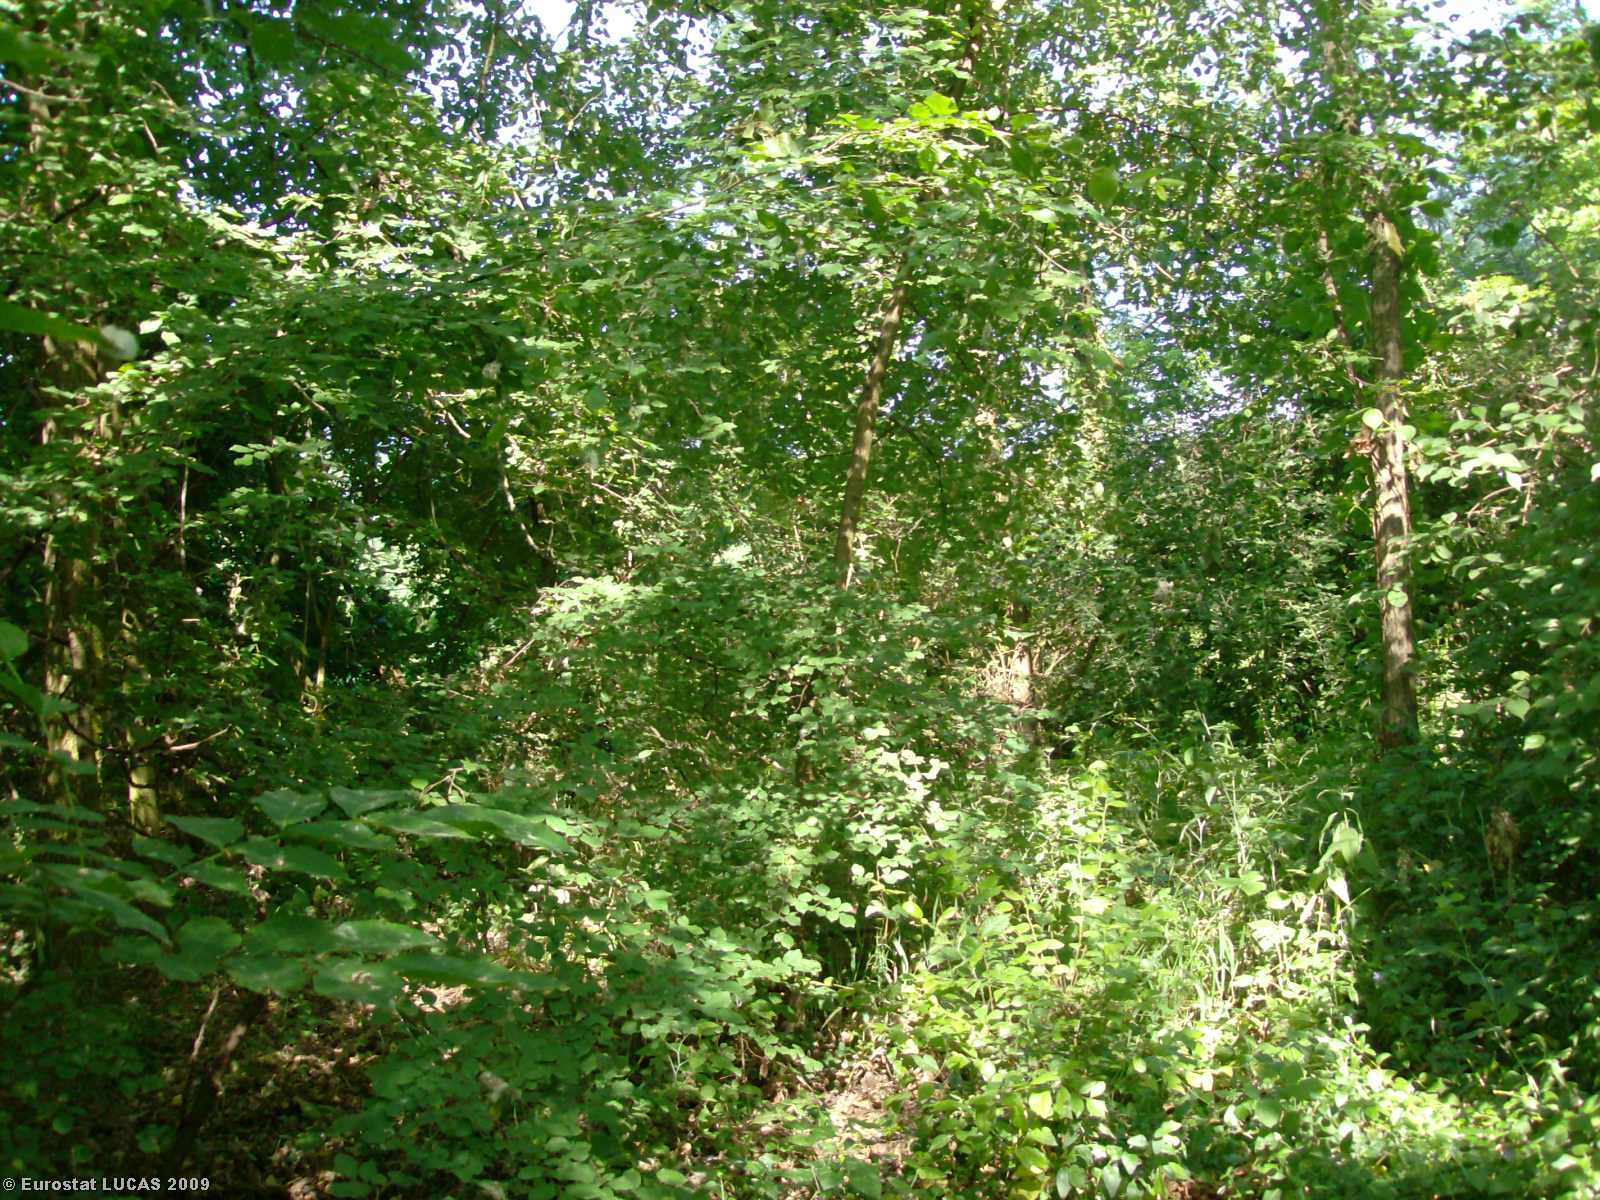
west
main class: Woodland
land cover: Broadleaved woodland
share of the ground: > 75 %
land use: Nature reserves
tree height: > 5 m
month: June
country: IT
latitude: 45.5574
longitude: 9.5268
